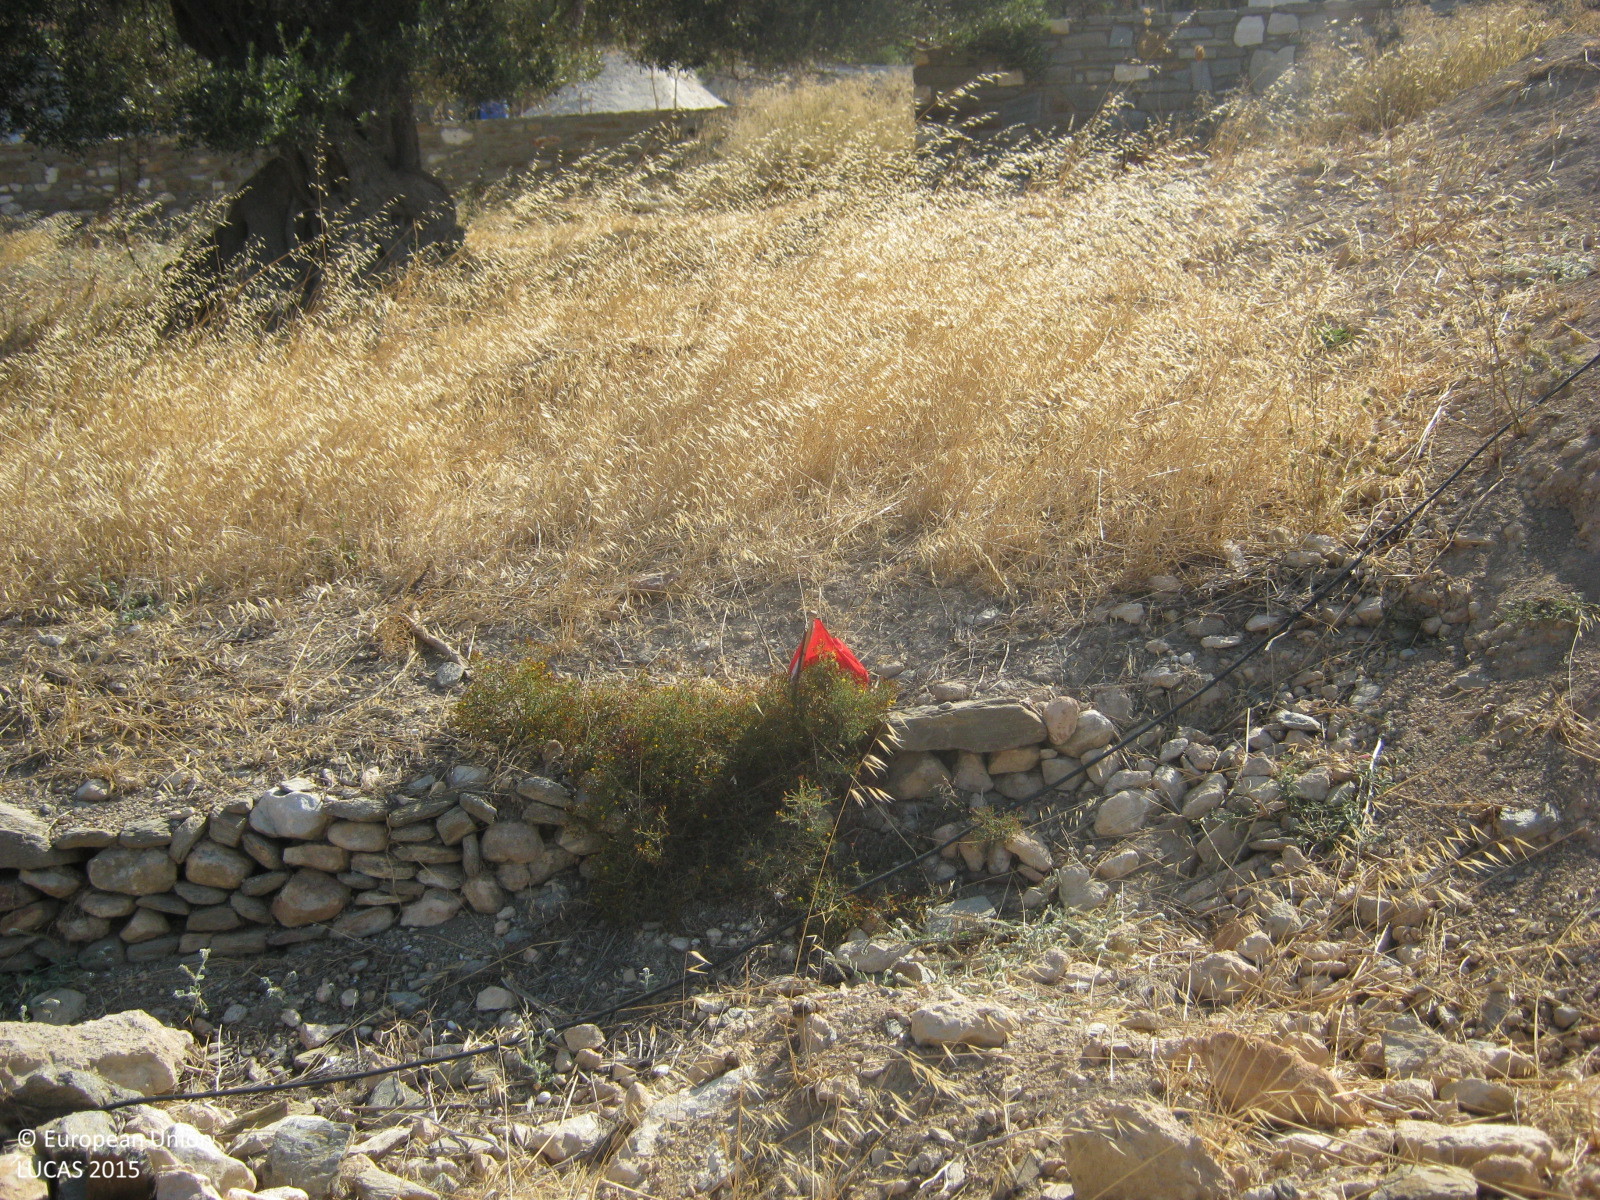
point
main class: Grassland
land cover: Grassland with sparse tree/shrub cover
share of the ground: > 75 %
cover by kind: herbaceous plants 95 %, coniferous forest trees 5 %
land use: Residential
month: August
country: GR
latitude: 37.0454
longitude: 25.1271
